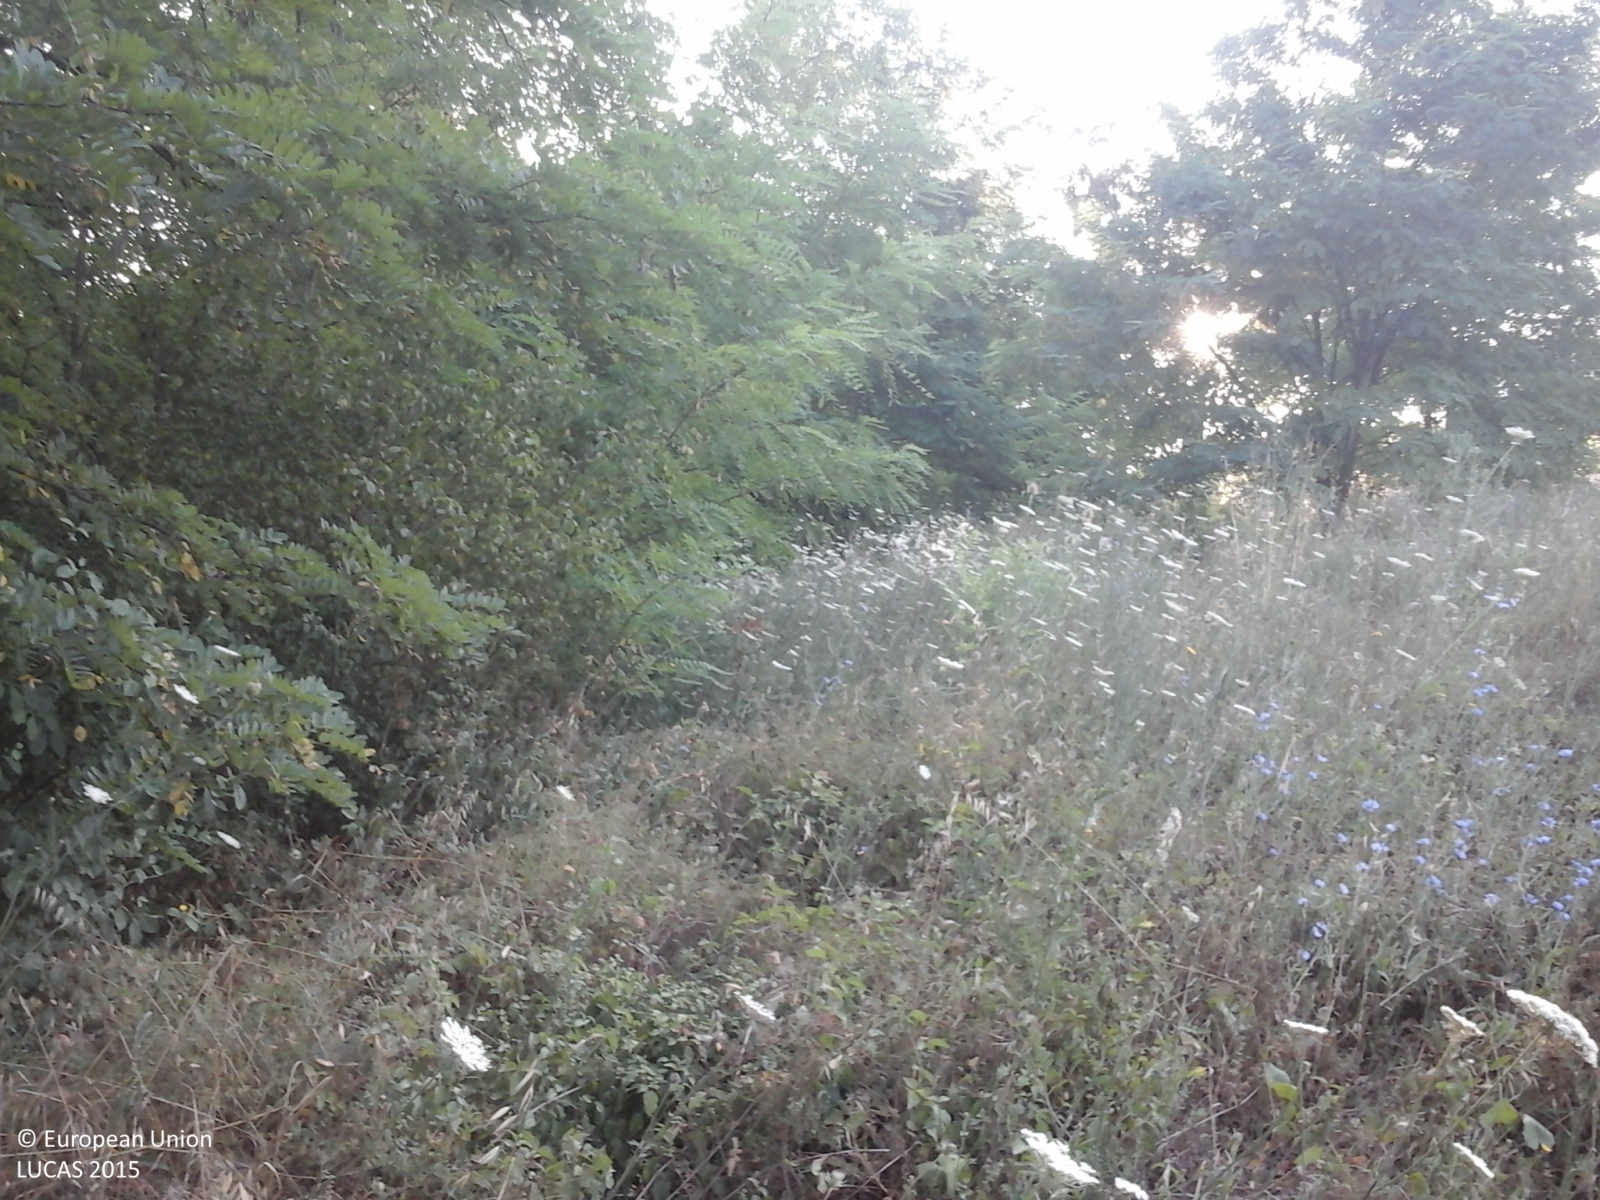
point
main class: Woodland
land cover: Broadleaved woodland
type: thermophilous deciduous forest
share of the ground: > 75 %
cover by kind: broadleaved forest trees 100 %
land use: Forestry
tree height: > 5 m
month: July
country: IT
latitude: 43.4603
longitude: 11.1215
